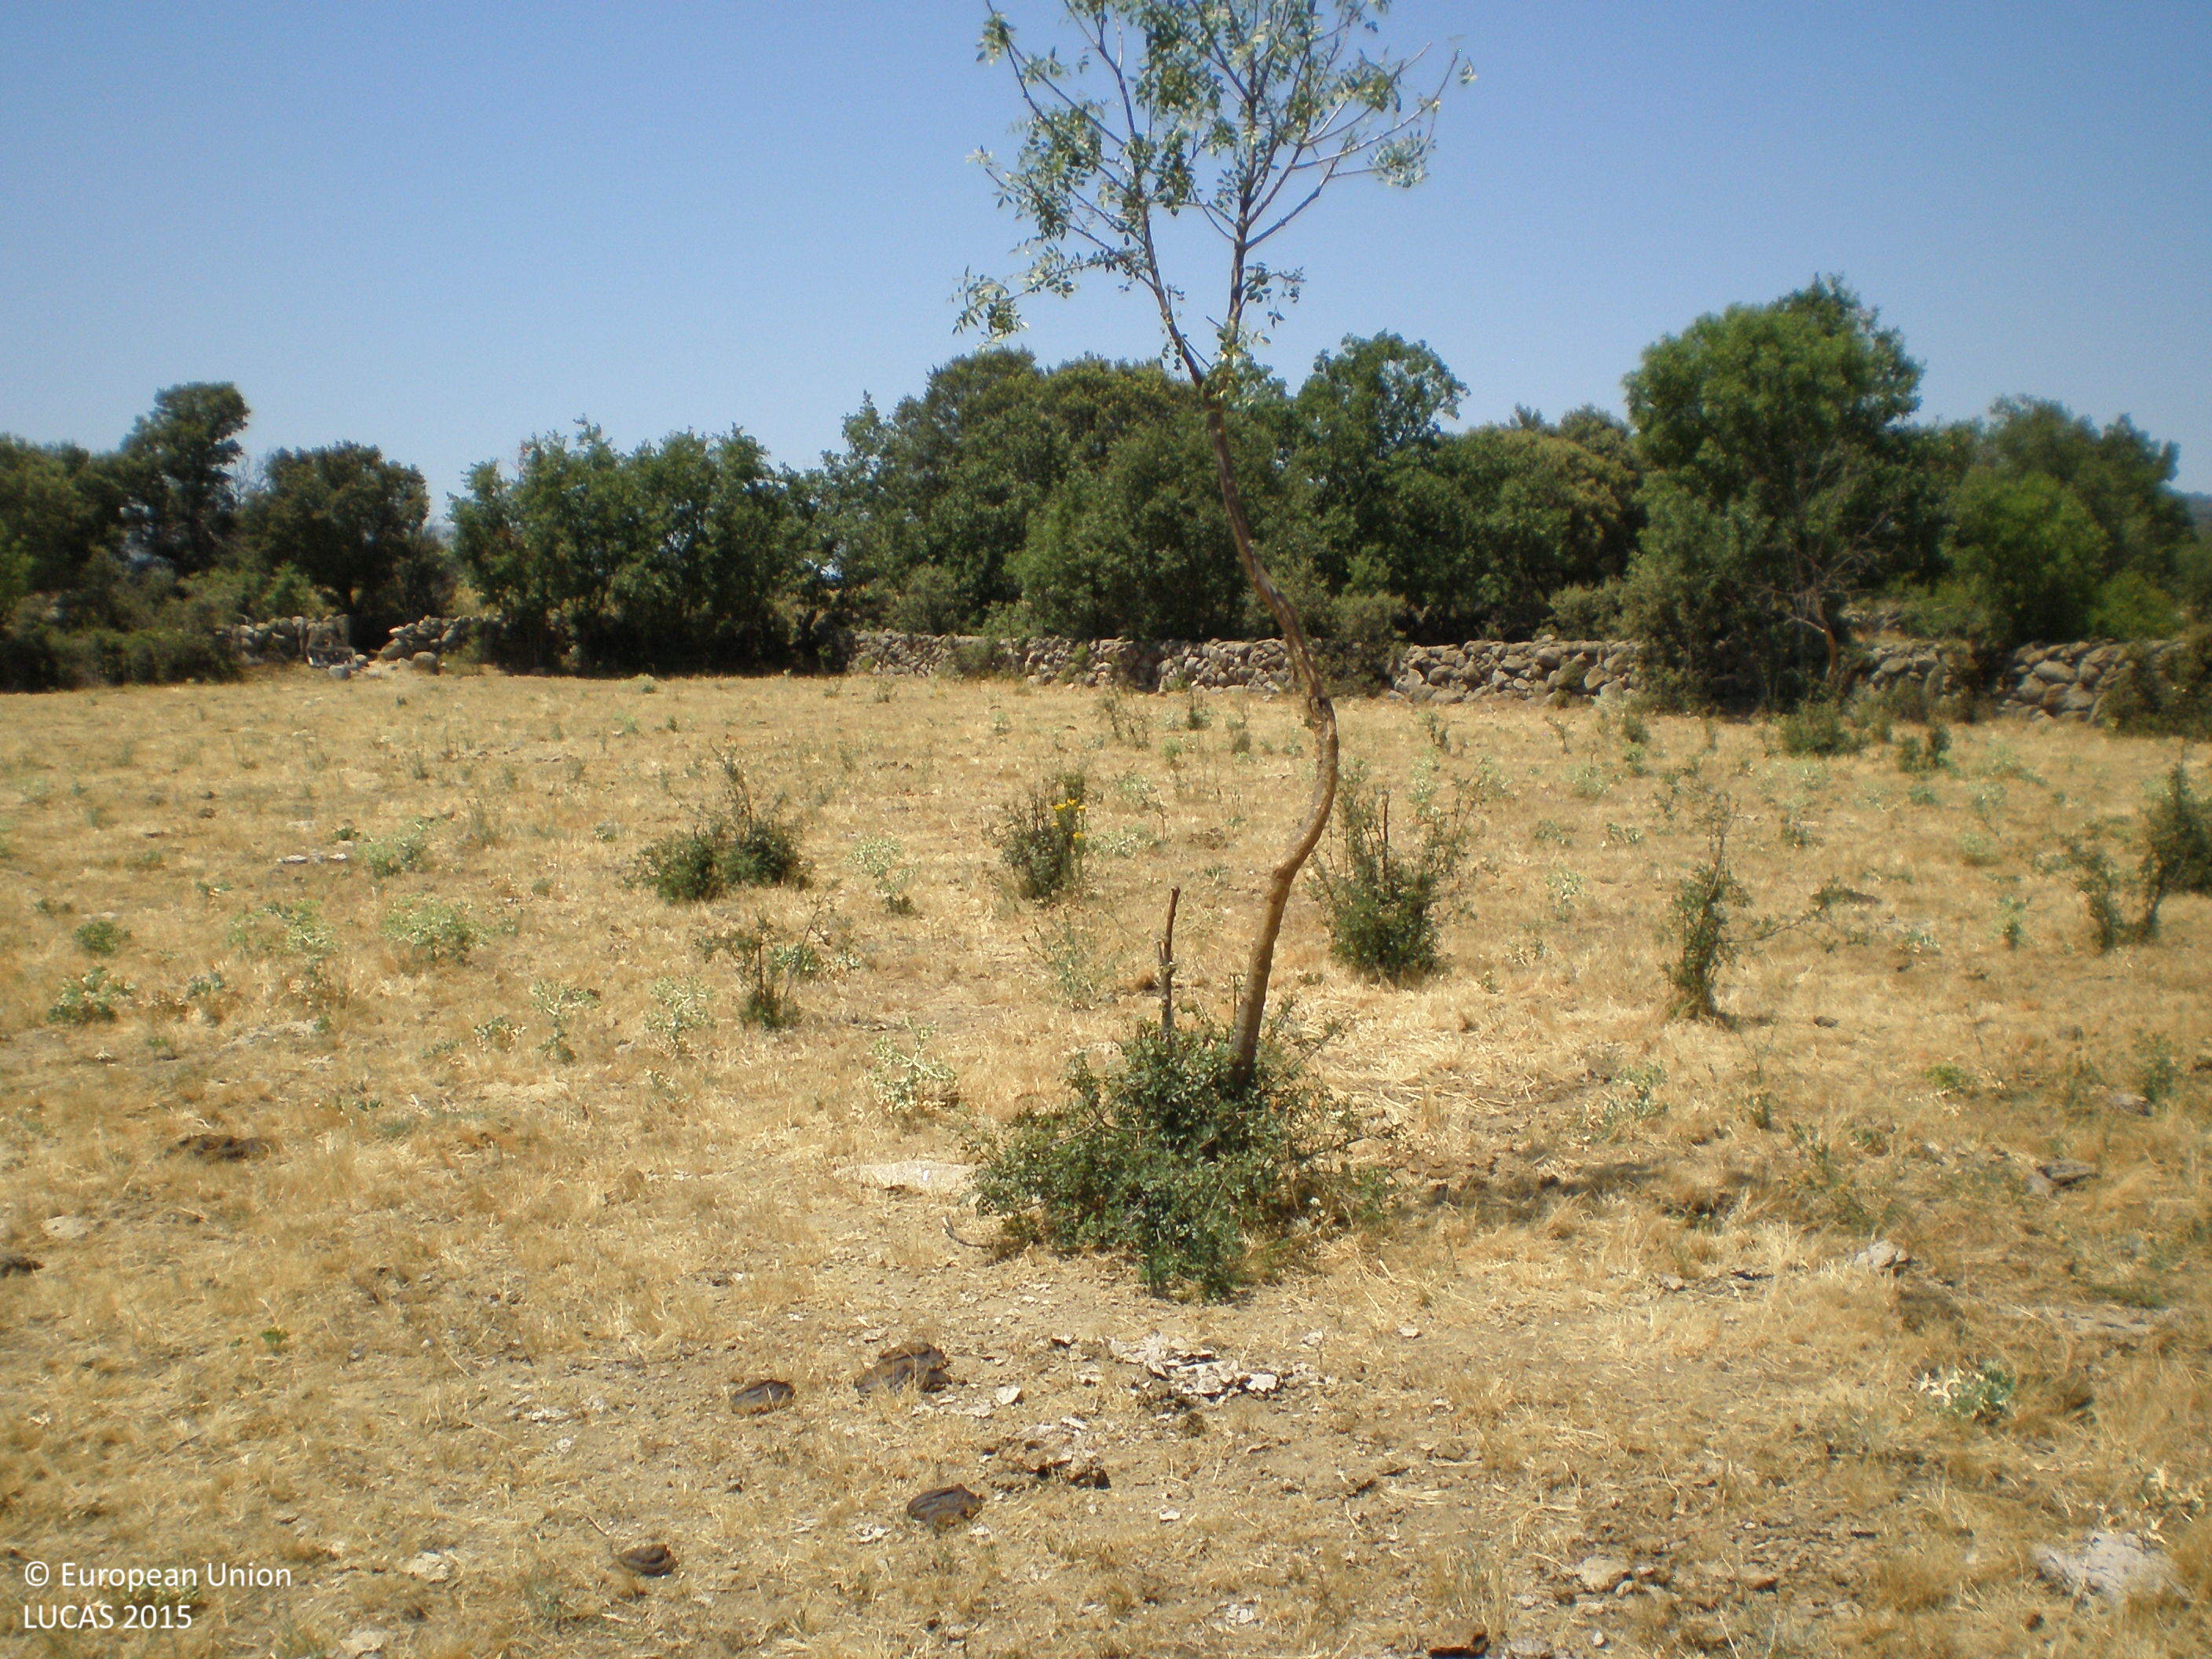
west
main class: Grassland
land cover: Grassland with sparse tree/shrub cover
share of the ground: > 75 %
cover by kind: herbaceous plants 95 %, broadleaved forest trees 5 %
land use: Agriculture (excluding fallow land and kitchen gardens)
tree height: < 5 m
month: July
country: ES
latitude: 40.4137
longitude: -5.5641
